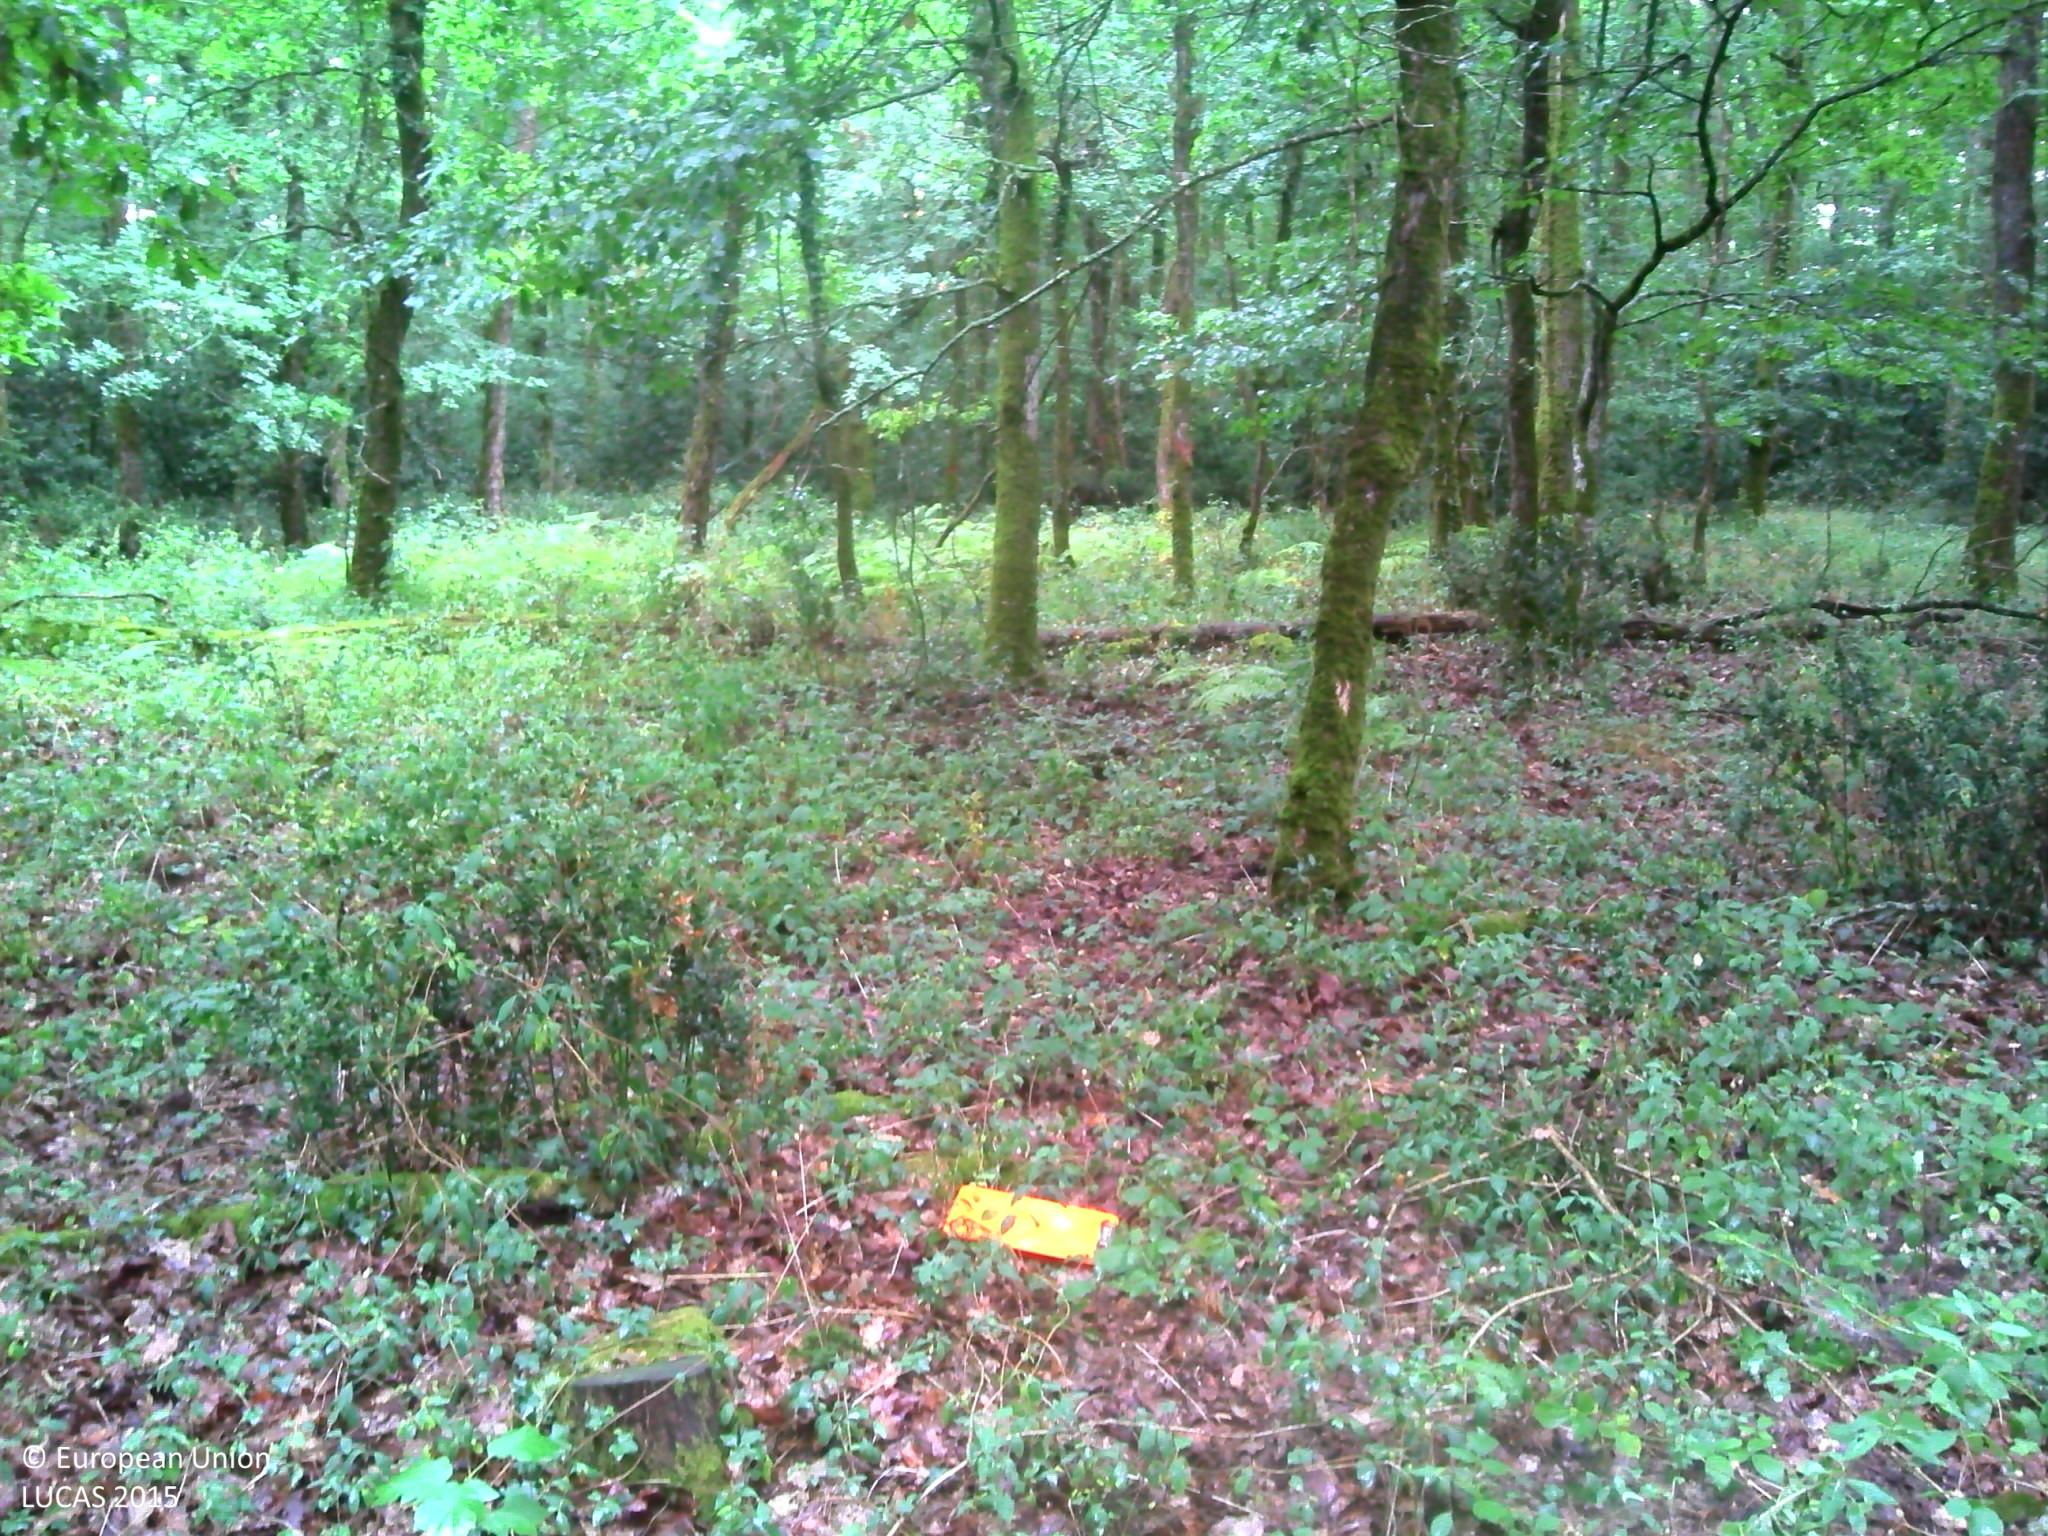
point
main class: Woodland
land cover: Broadleaved woodland
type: acidophilous oak and oak-birch forest
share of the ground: > 75 %
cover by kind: broadleaved forest trees 95 %, herbaceous plants 5 %
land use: Forestry
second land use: Amenities, museums, leisure
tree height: > 5 m
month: July
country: FR
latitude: 47.4969
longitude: -1.7946
